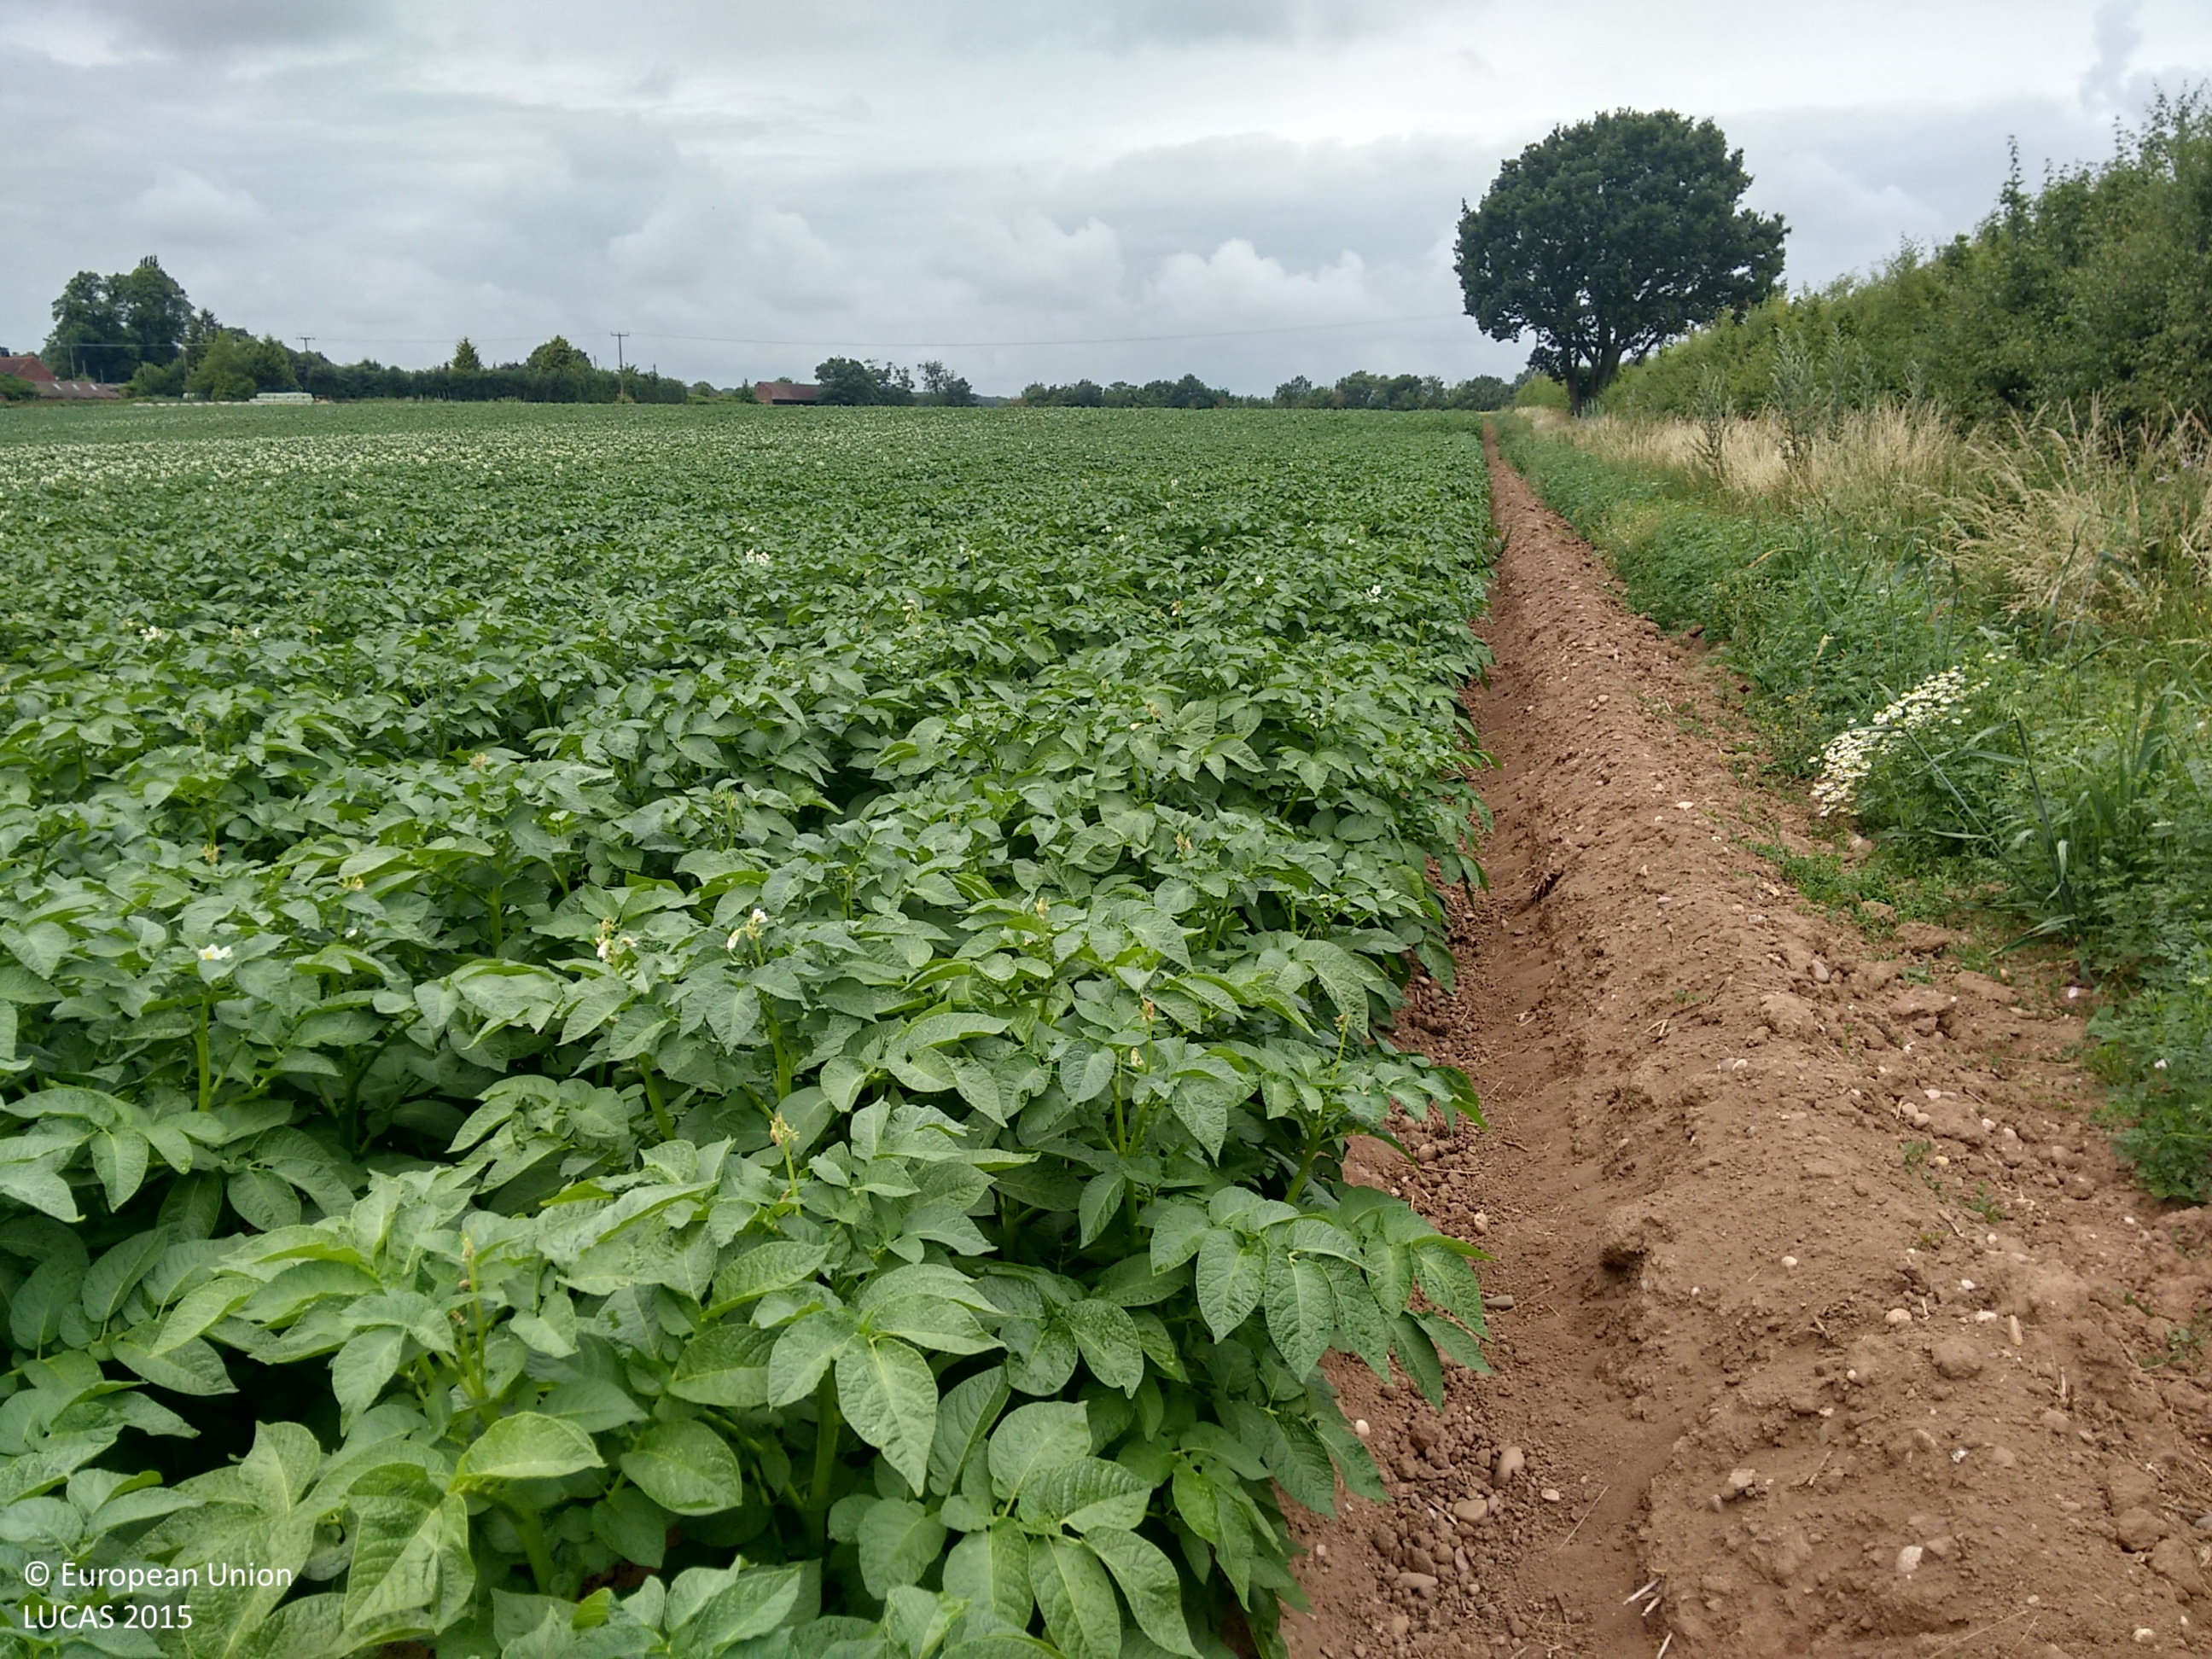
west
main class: Cropland
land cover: Potatoes
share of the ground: > 75 %
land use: Agriculture (excluding fallow land and kitchen gardens)
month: July
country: GB
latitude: 52.2334
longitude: -2.2297
